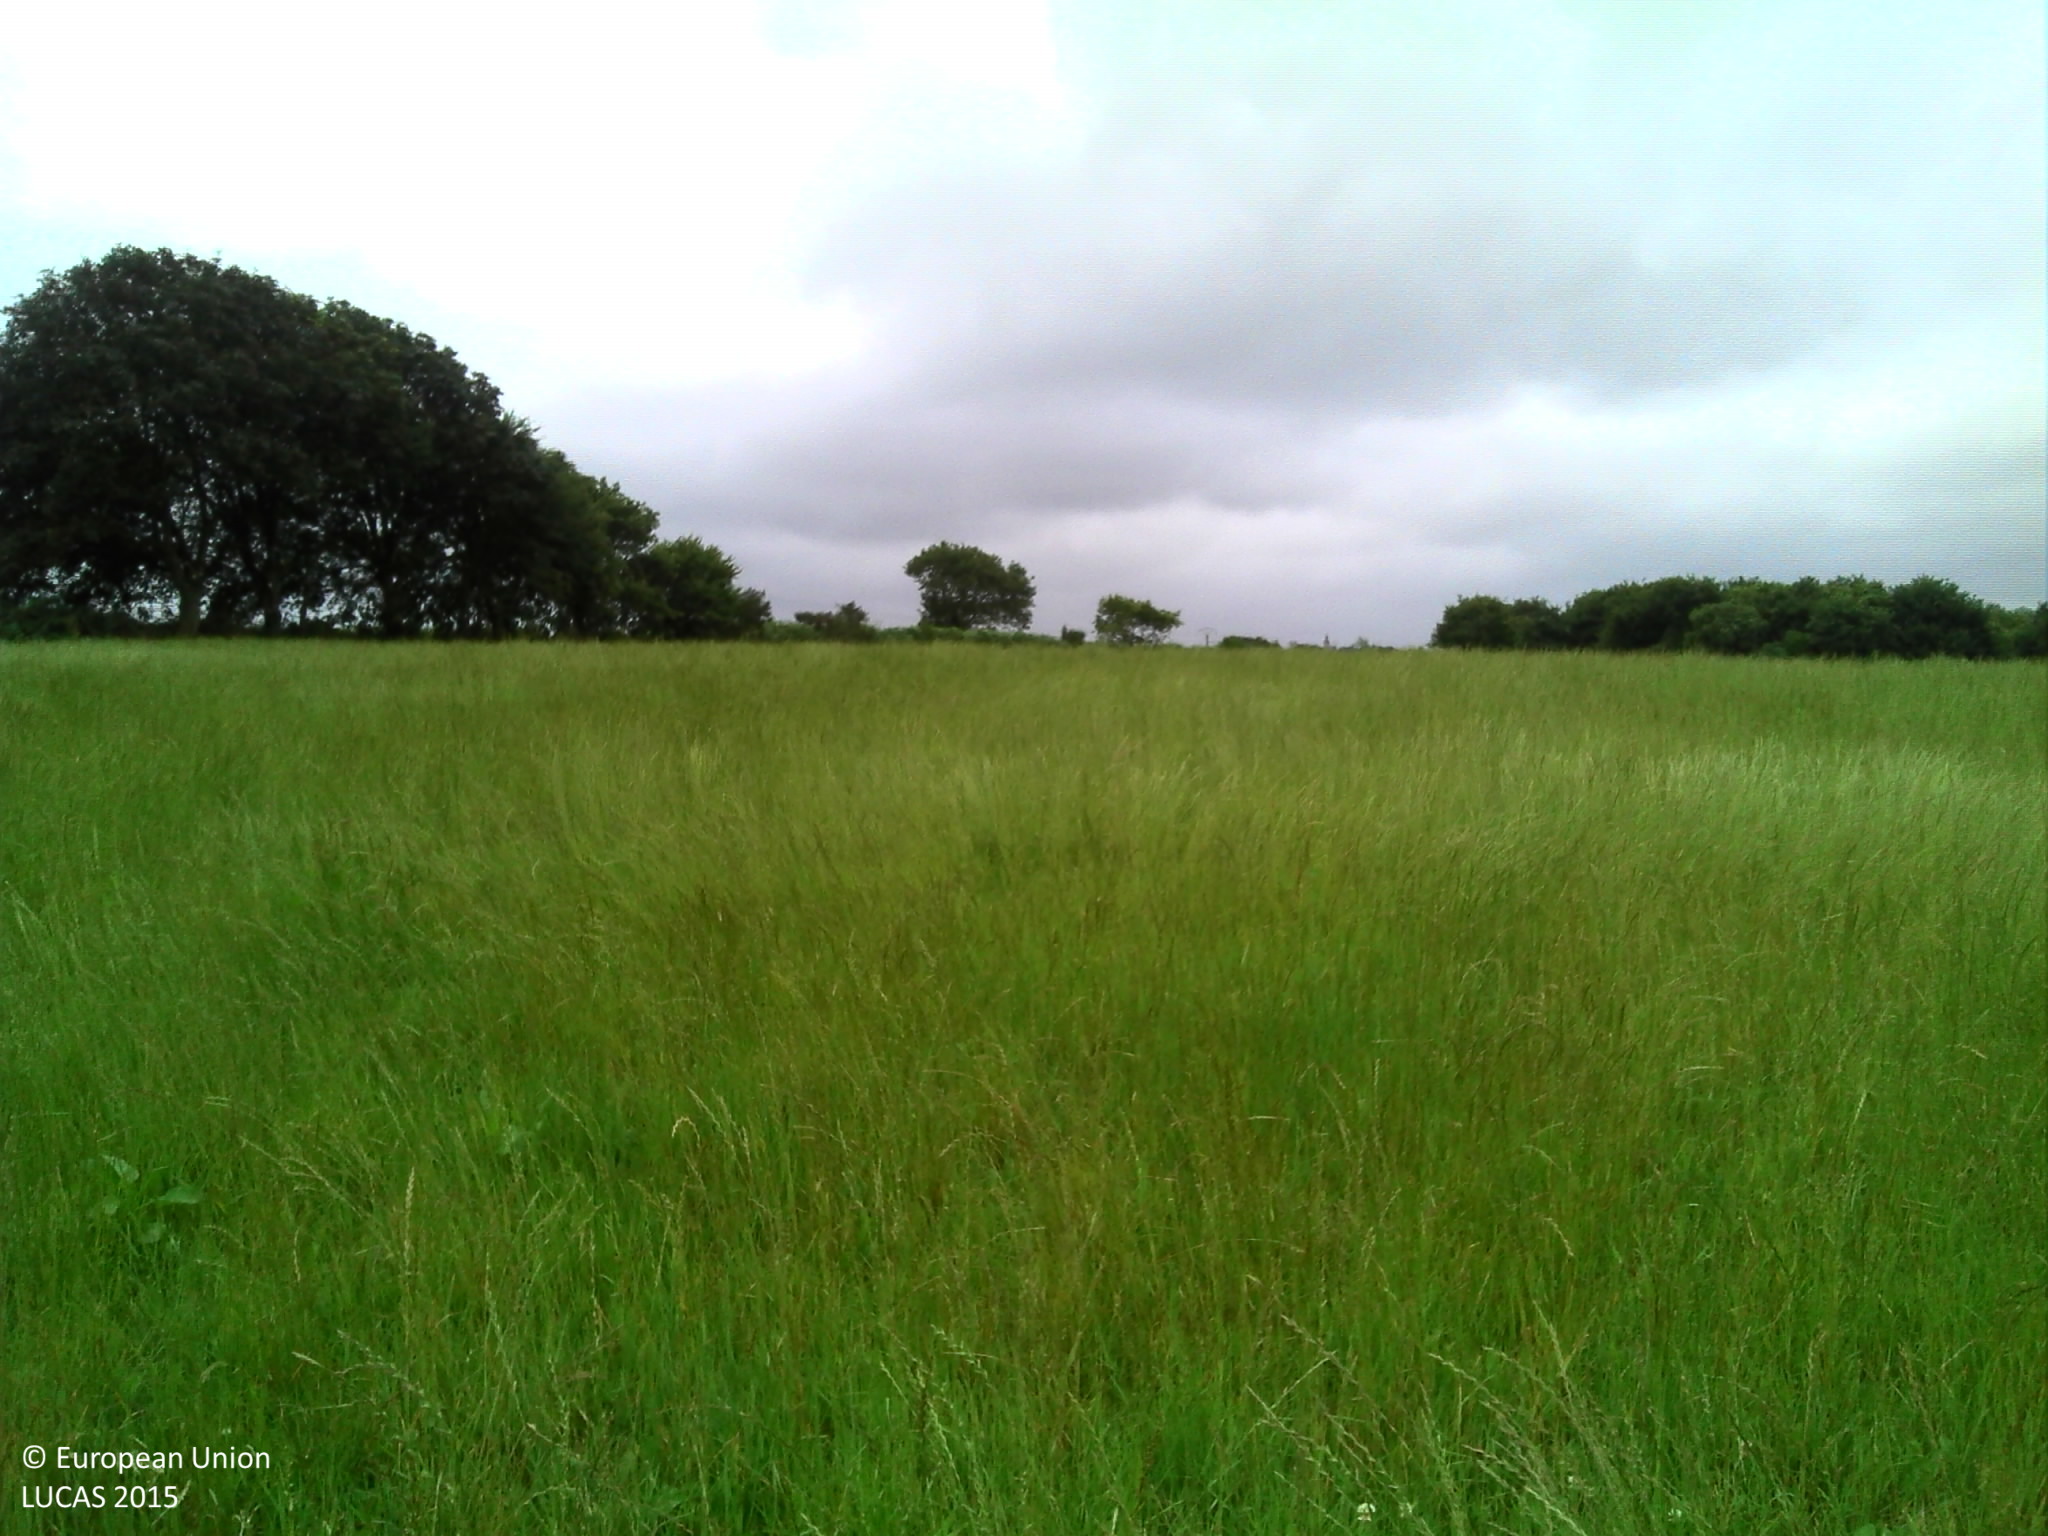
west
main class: Grassland
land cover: Grassland without tree/shrub cover
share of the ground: > 75 %
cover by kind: herbaceous plants 100 %
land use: Agriculture (excluding fallow land and kitchen gardens)
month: August
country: FR
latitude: 48.3885
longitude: -3.0753
